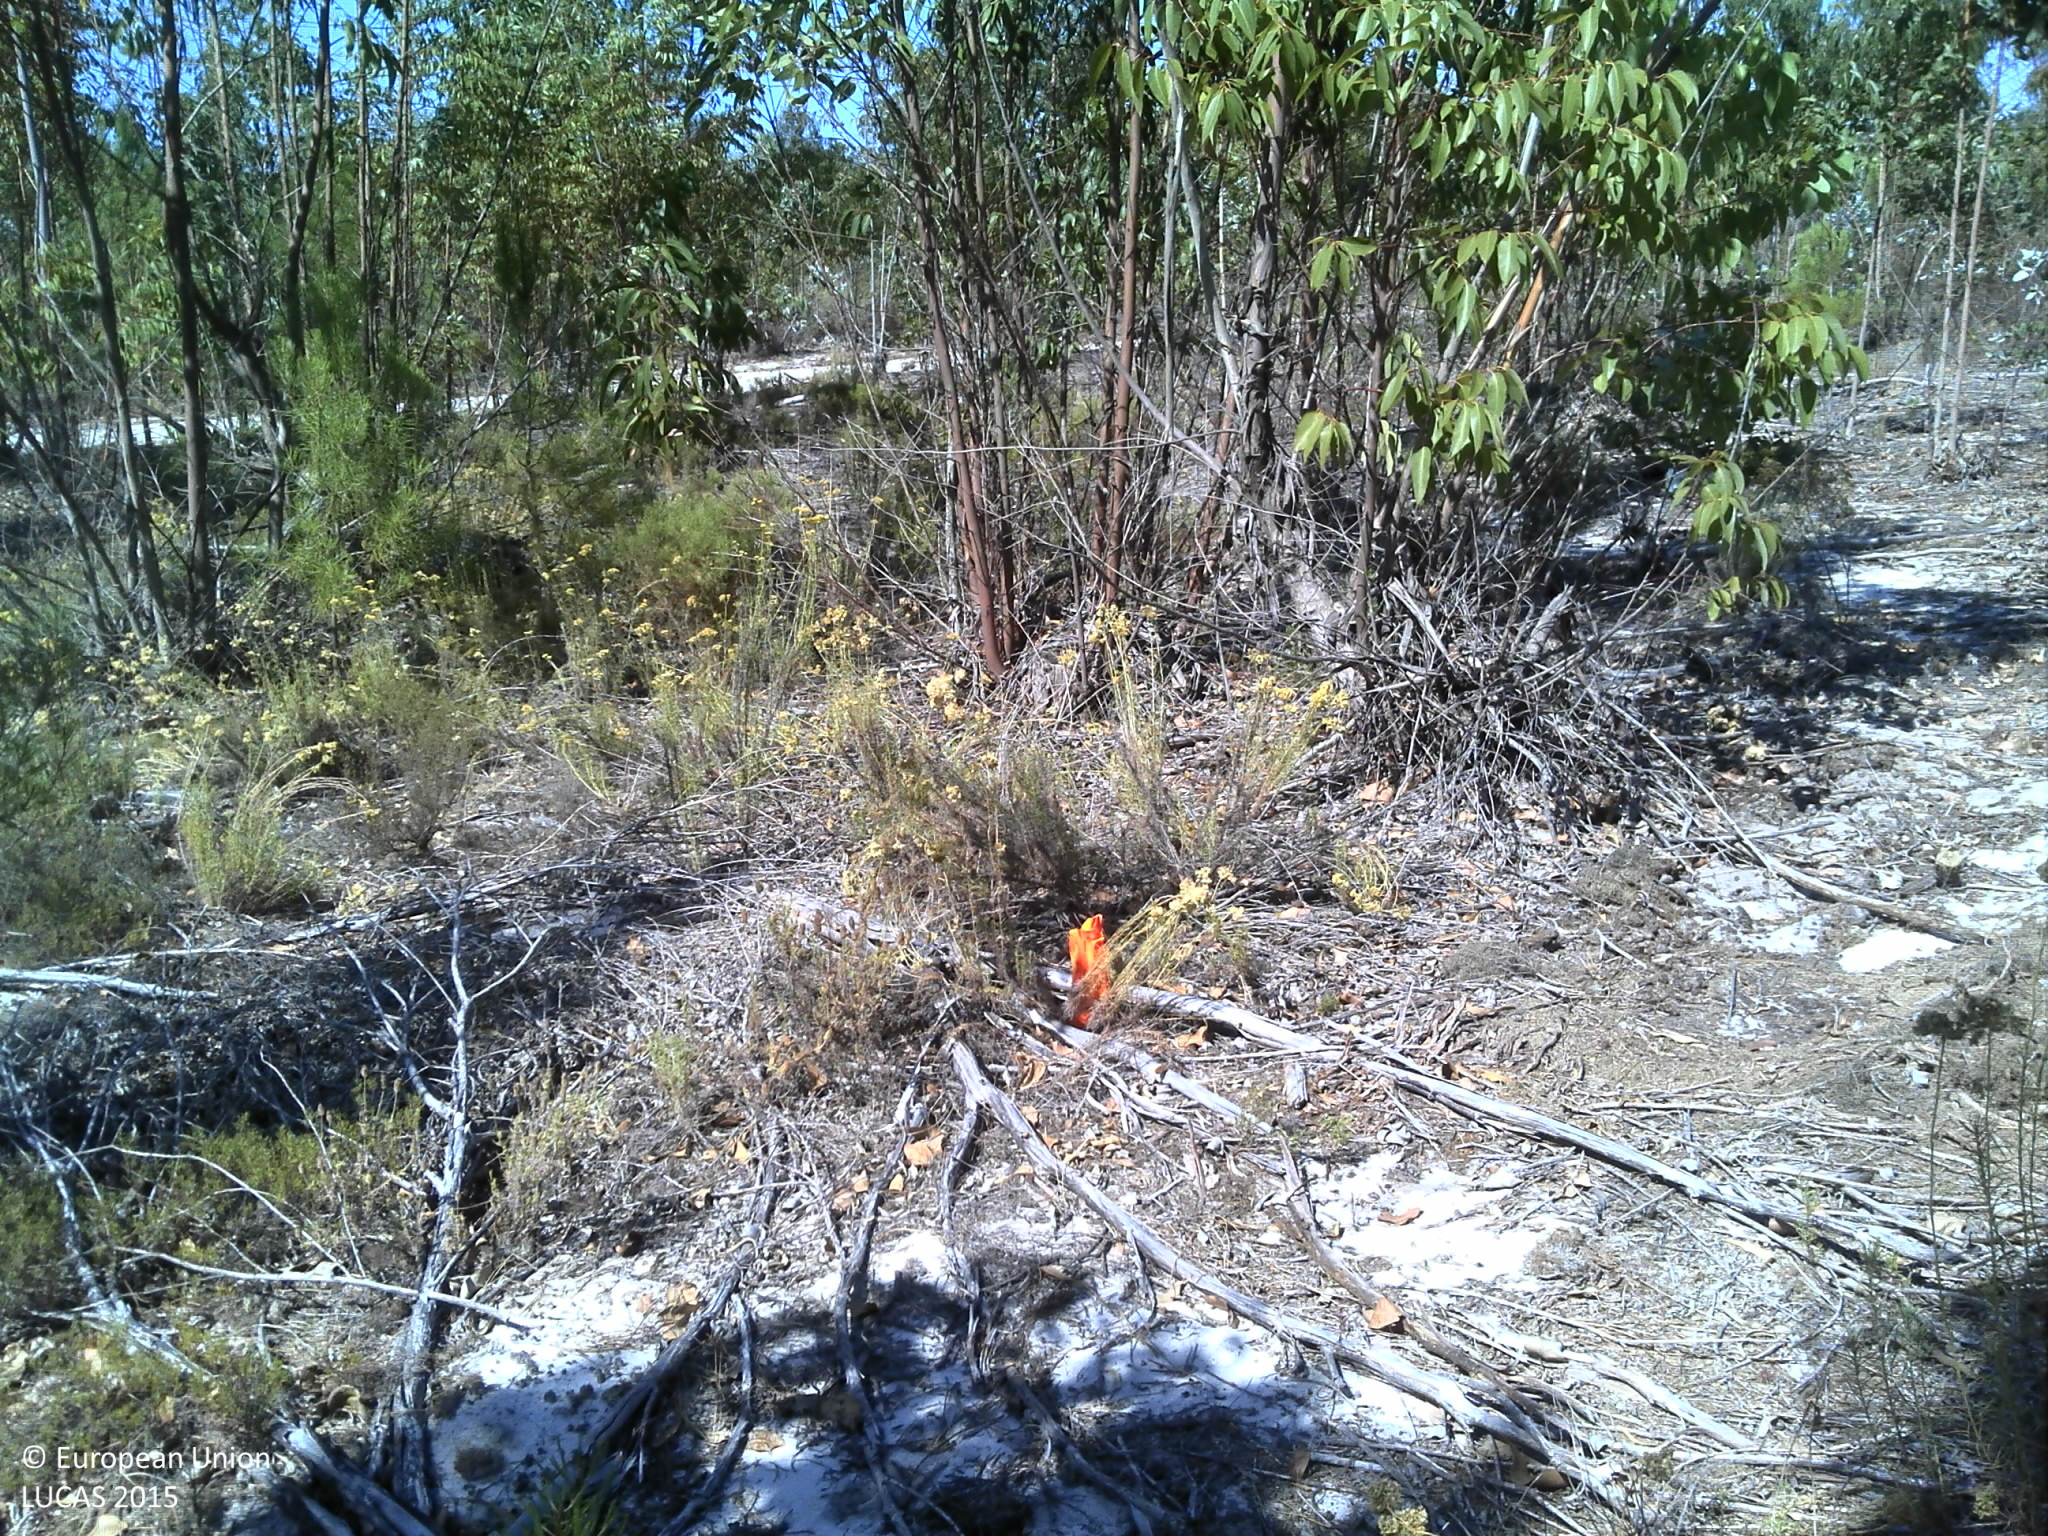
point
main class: Woodland
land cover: Broadleaved woodland
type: exotic forest
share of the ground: 25 - 50 %
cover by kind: broadleaved forest trees 40 %, unconsolidated bare surface 35 %, shrubs 10 %, herbaceous plants 10 %, coniferous forest trees 5 %
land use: Forestry
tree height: > 5 m
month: July
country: PT
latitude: 38.3108
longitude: -8.6607
